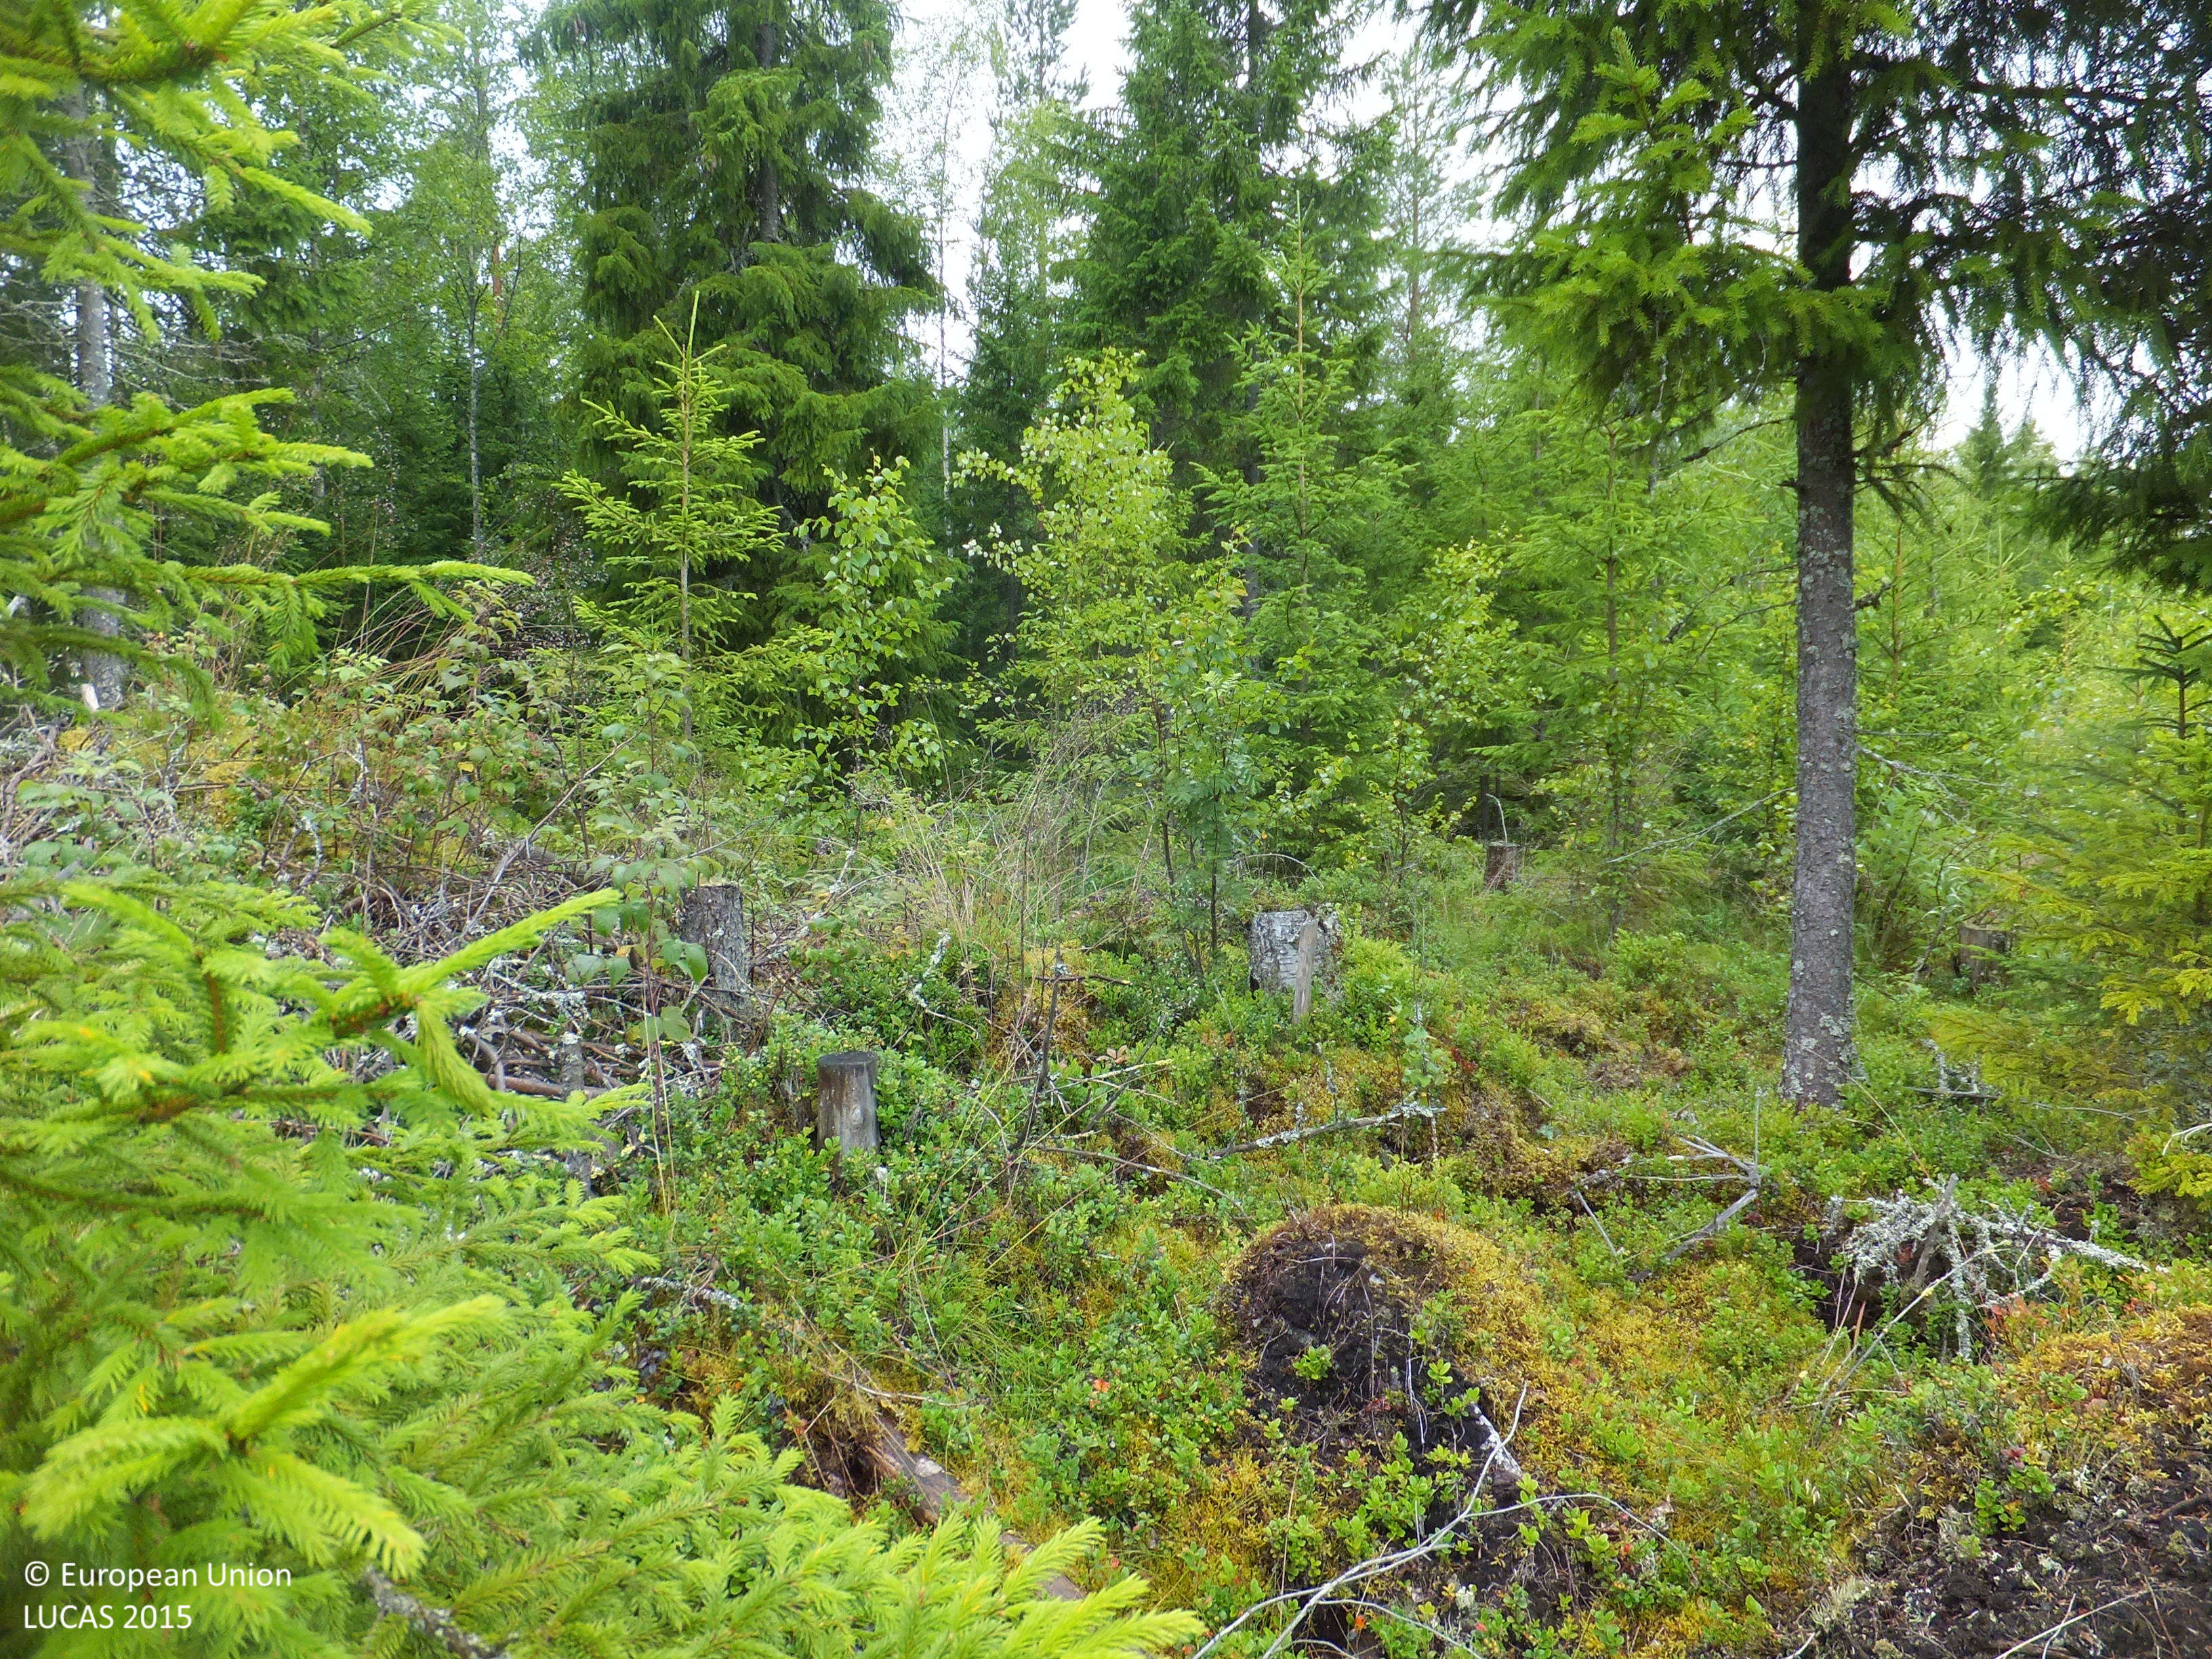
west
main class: Woodland
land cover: Spruce dominated mixed woodland
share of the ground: 10 - 25 %
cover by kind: shrubs 30 %, herbaceous plants 20 %, lichens and mosses 20 %, coniferous forest trees 10 %, broadleaved forest trees 10 %, consolidated bare surface 10 %
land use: Forestry
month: July
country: FI
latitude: 63.0324
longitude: 21.9231
